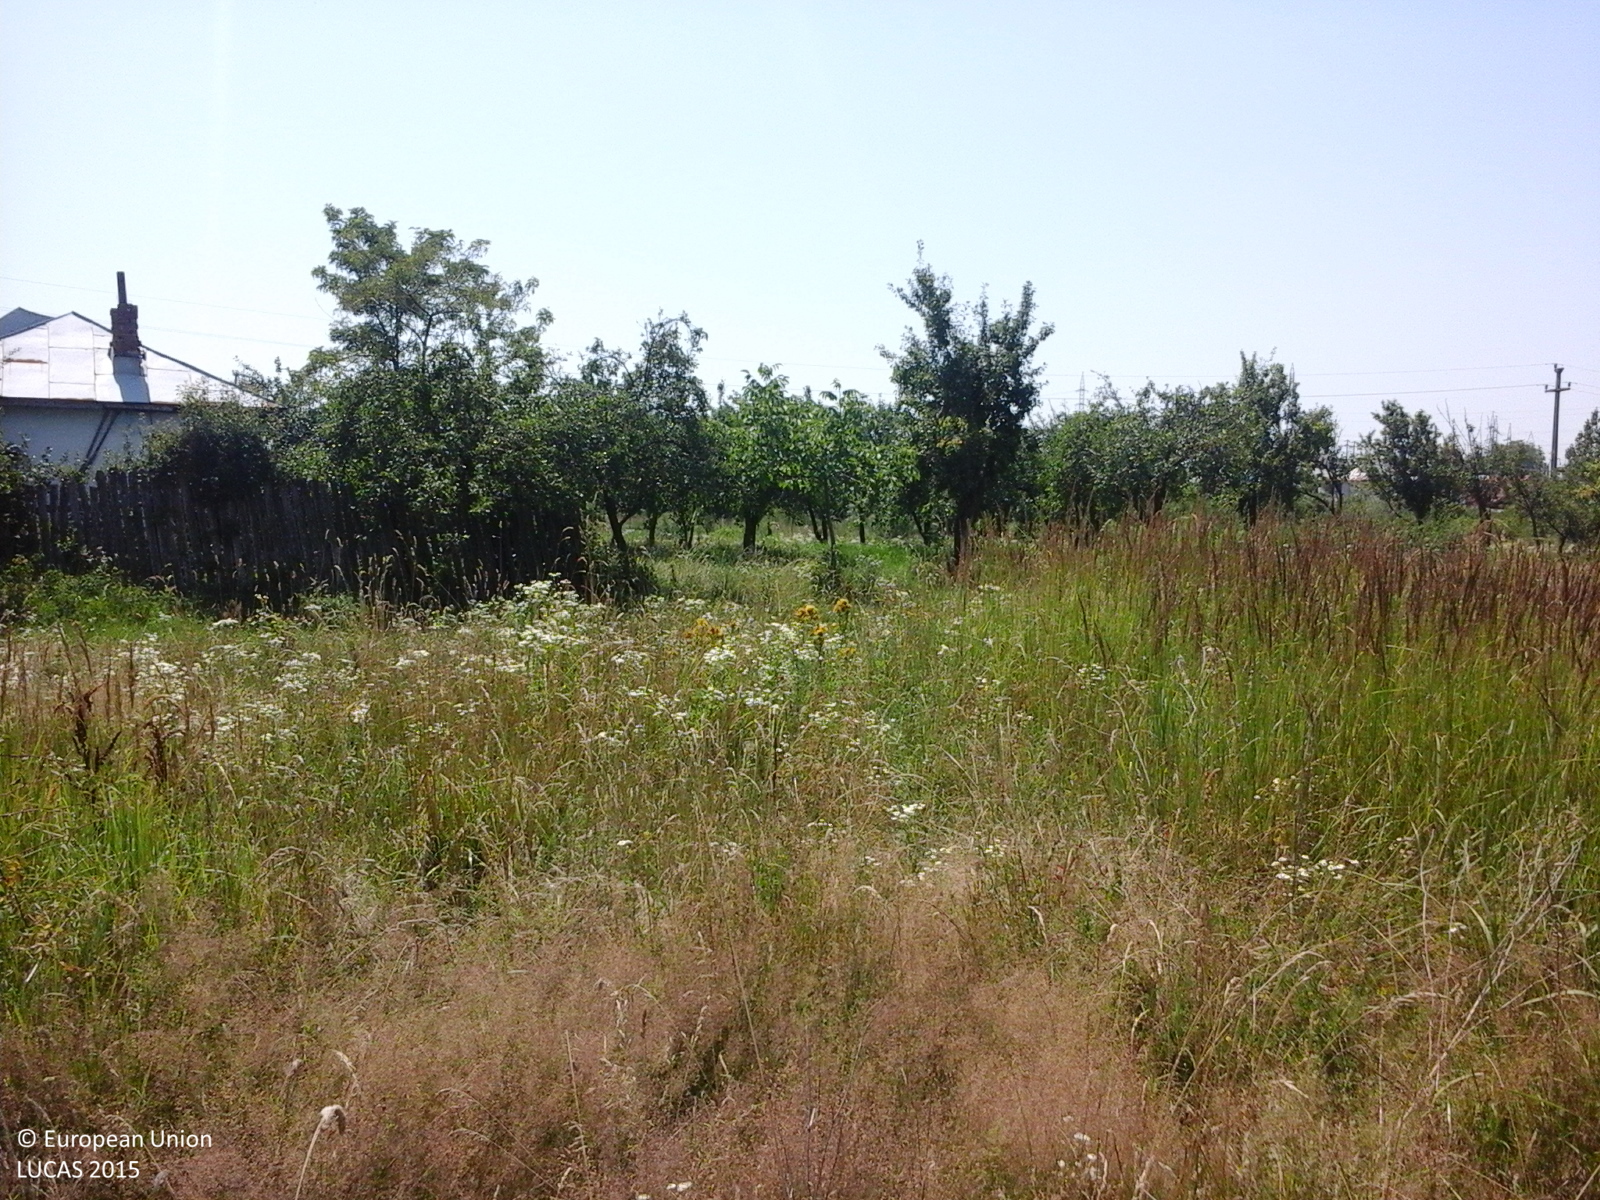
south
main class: Grassland
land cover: Spontaneously vegetated surfaces
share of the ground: > 75 %
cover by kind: herbaceous plants 100 %
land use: Agriculture (excluding fallow land and kitchen gardens)
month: July
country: RO
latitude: 44.7691
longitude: 24.9026
